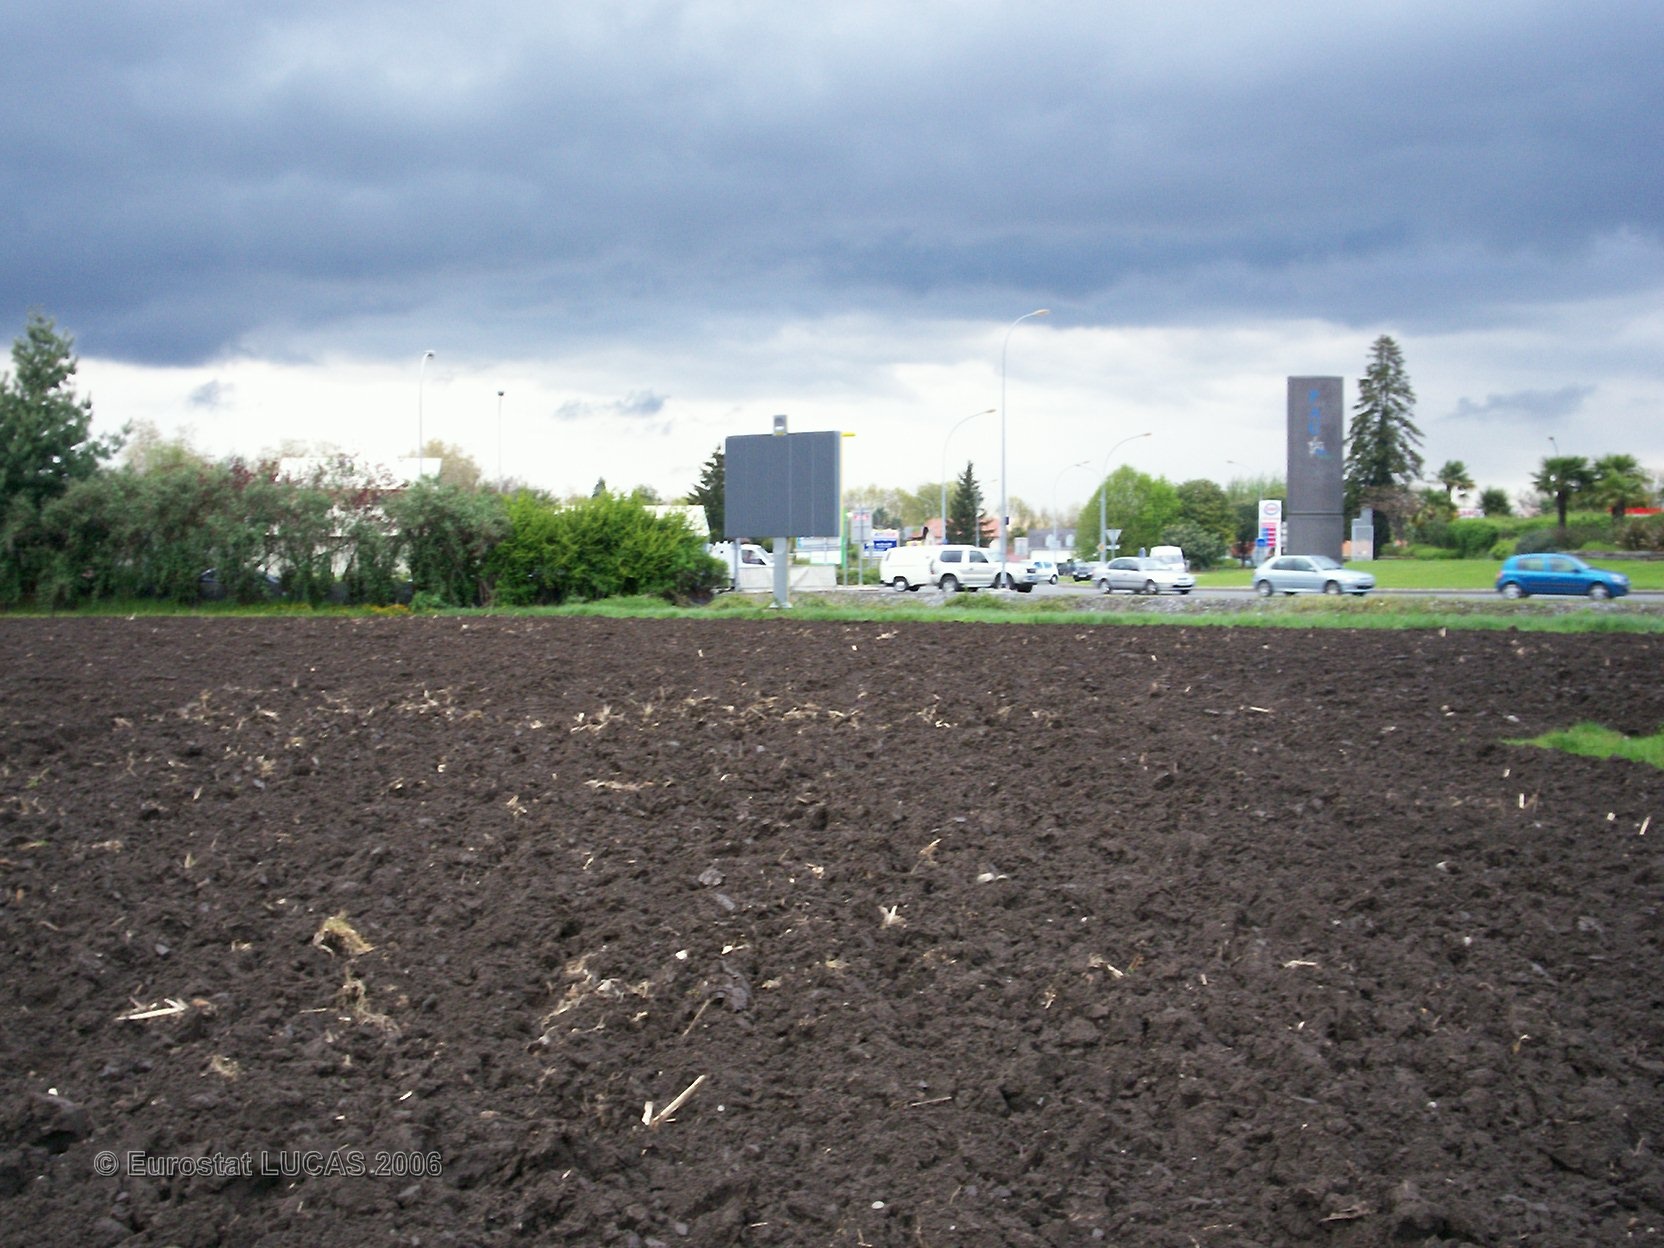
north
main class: Cropland
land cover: Maize
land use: Agriculture (excluding fallow land and kitchen gardens)
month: June
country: FR
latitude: 43.3378
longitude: -0.3804
